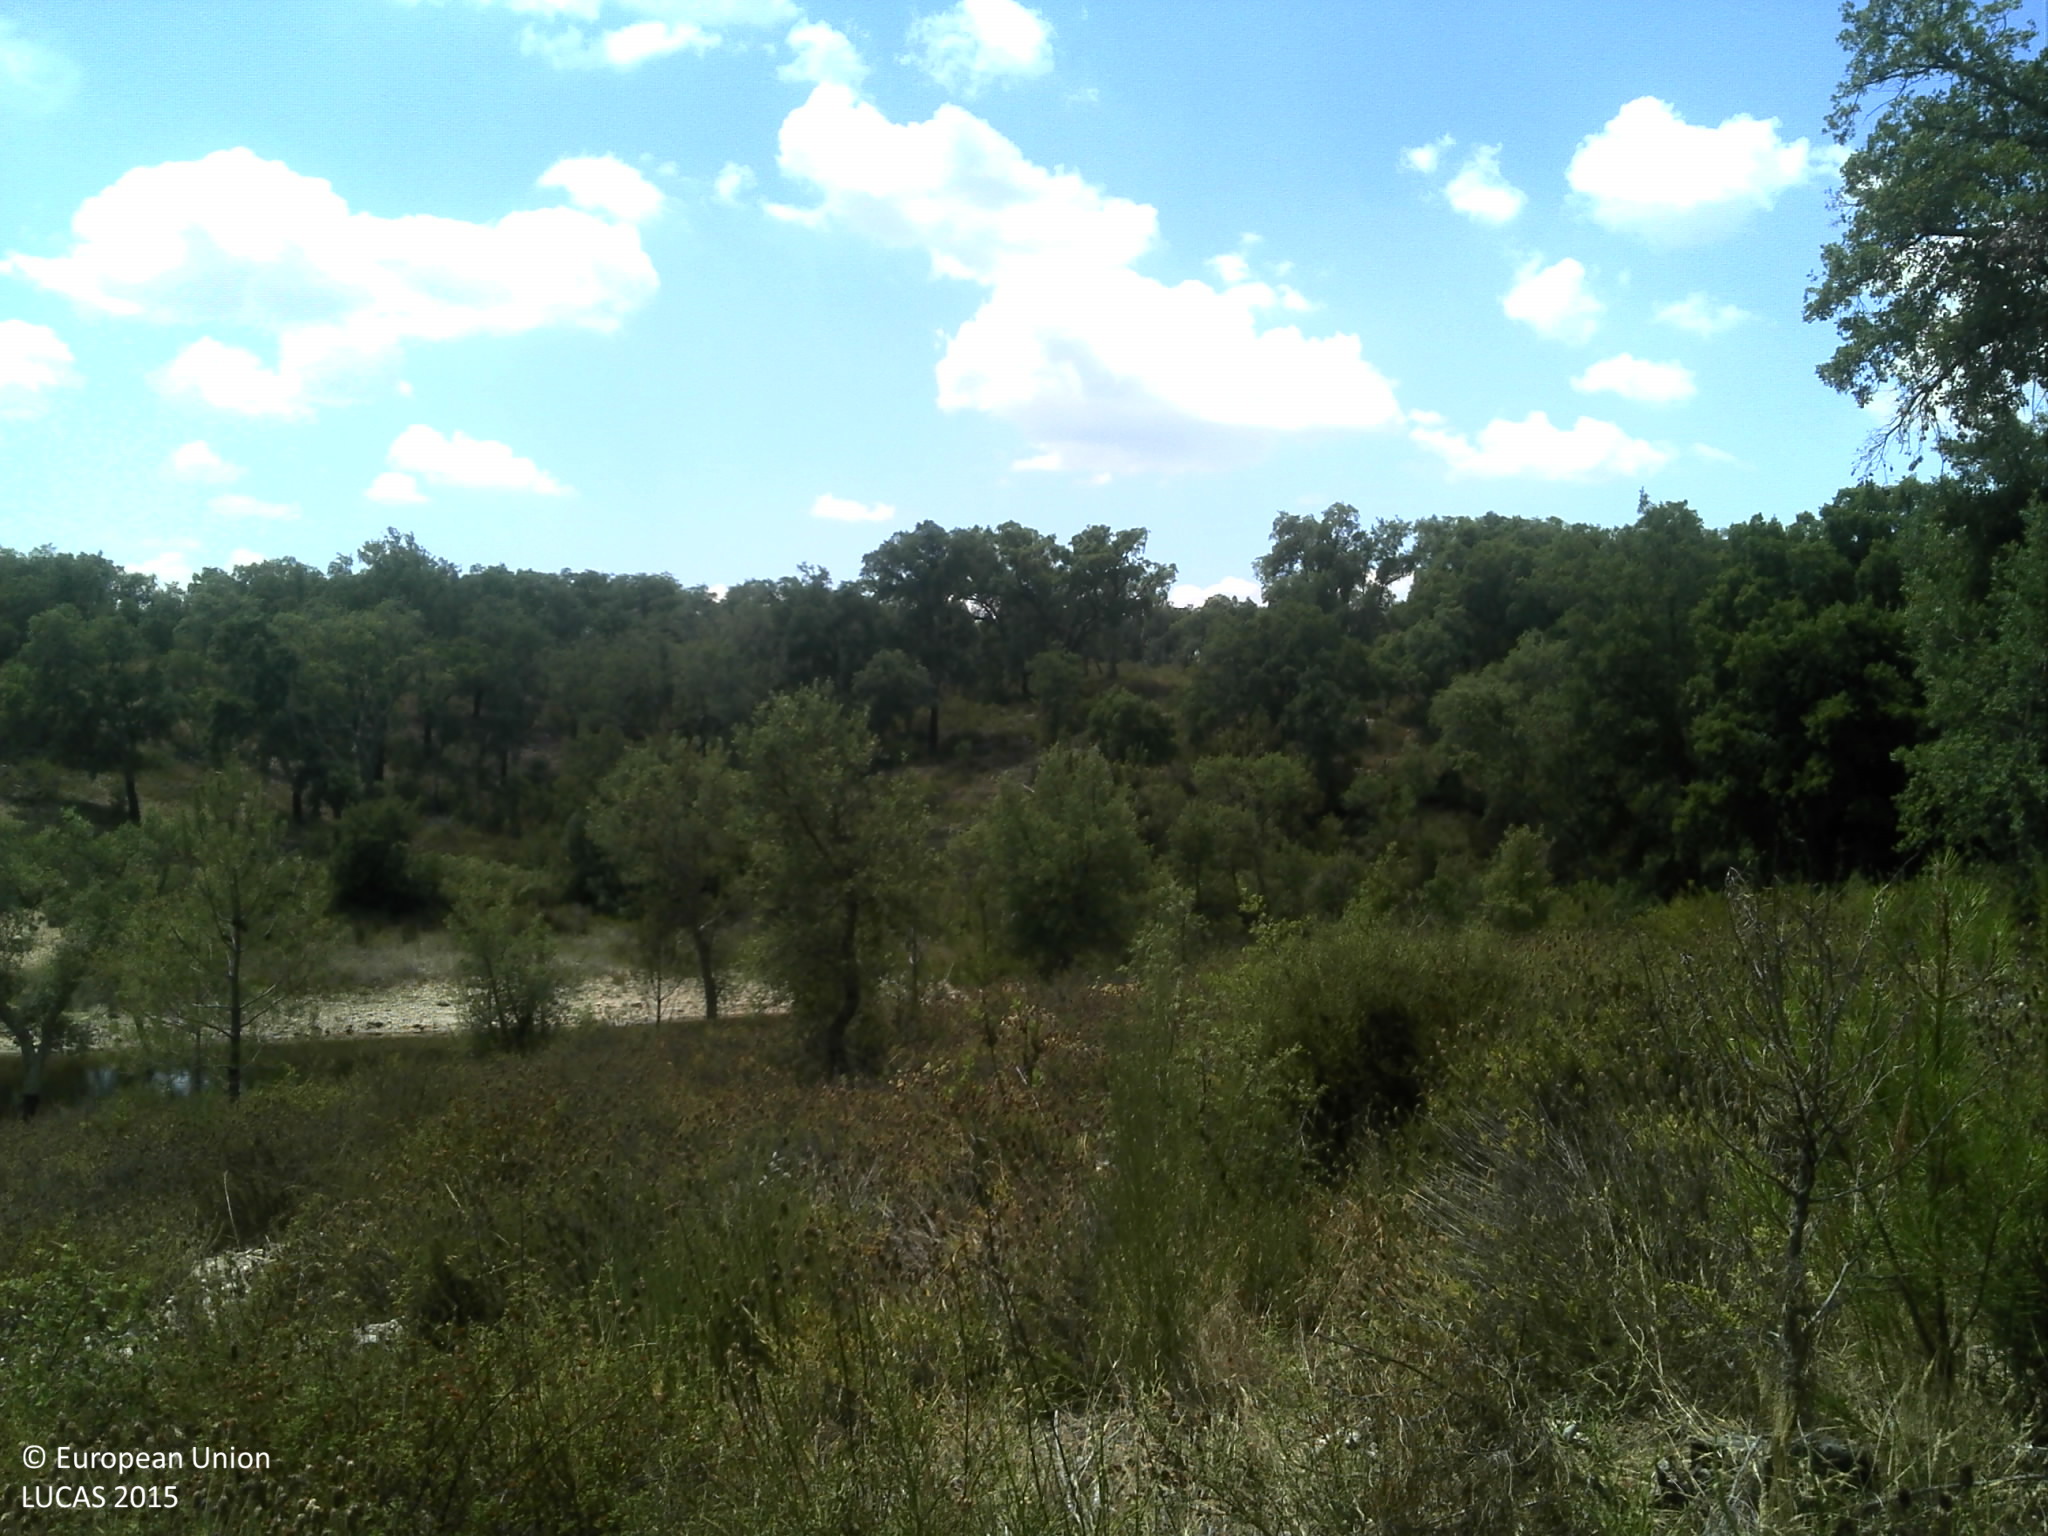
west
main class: Woodland
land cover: Broadleaved woodland
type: broadleaved evergreen forest
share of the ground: 10 - 25 %
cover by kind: unconsolidated bare surface 40 %, broadleaved forest trees 25 %, shrubs 25 %, herbaceous plants 10 %
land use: Forestry
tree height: > 5 m
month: June
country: PT
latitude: 39.2745
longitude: -8.2726
